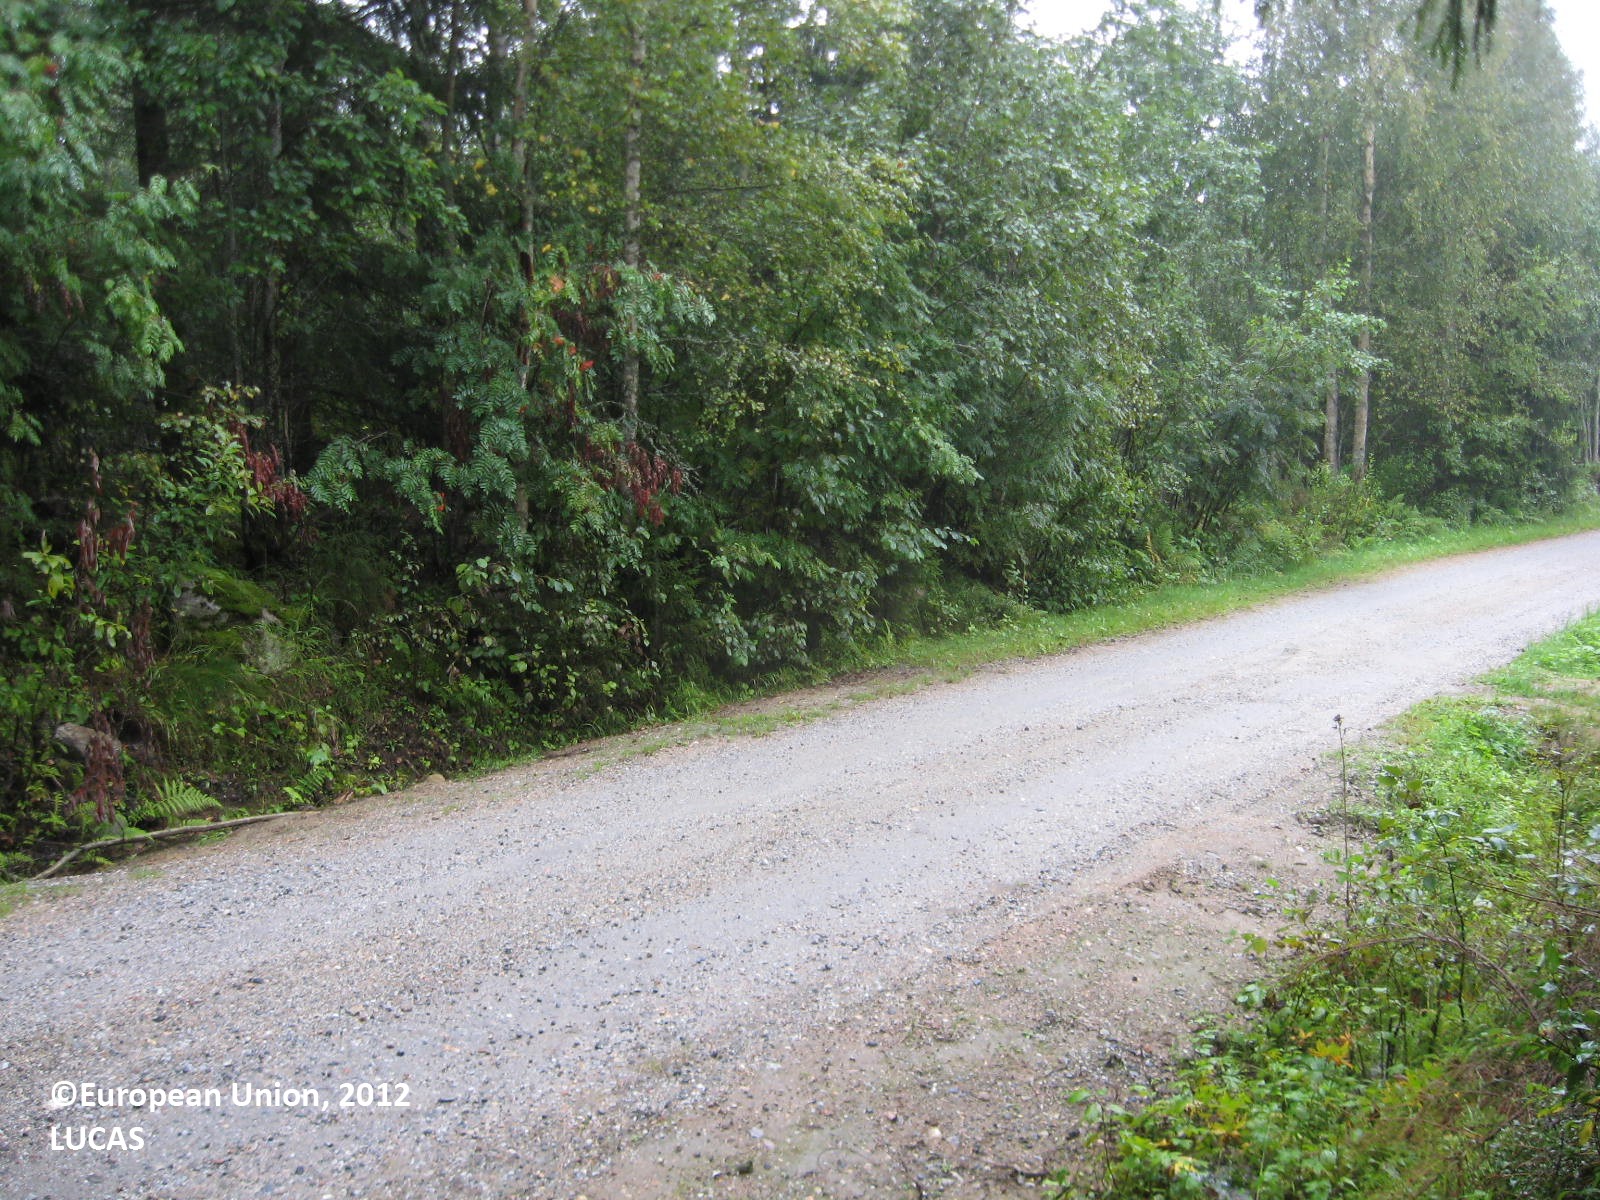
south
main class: Woodland
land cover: Spruce dominated coniferous woodland
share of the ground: > 75 %
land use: Forestry
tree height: > 5 m
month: August
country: FI
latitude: 63.5694
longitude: 29.5809
